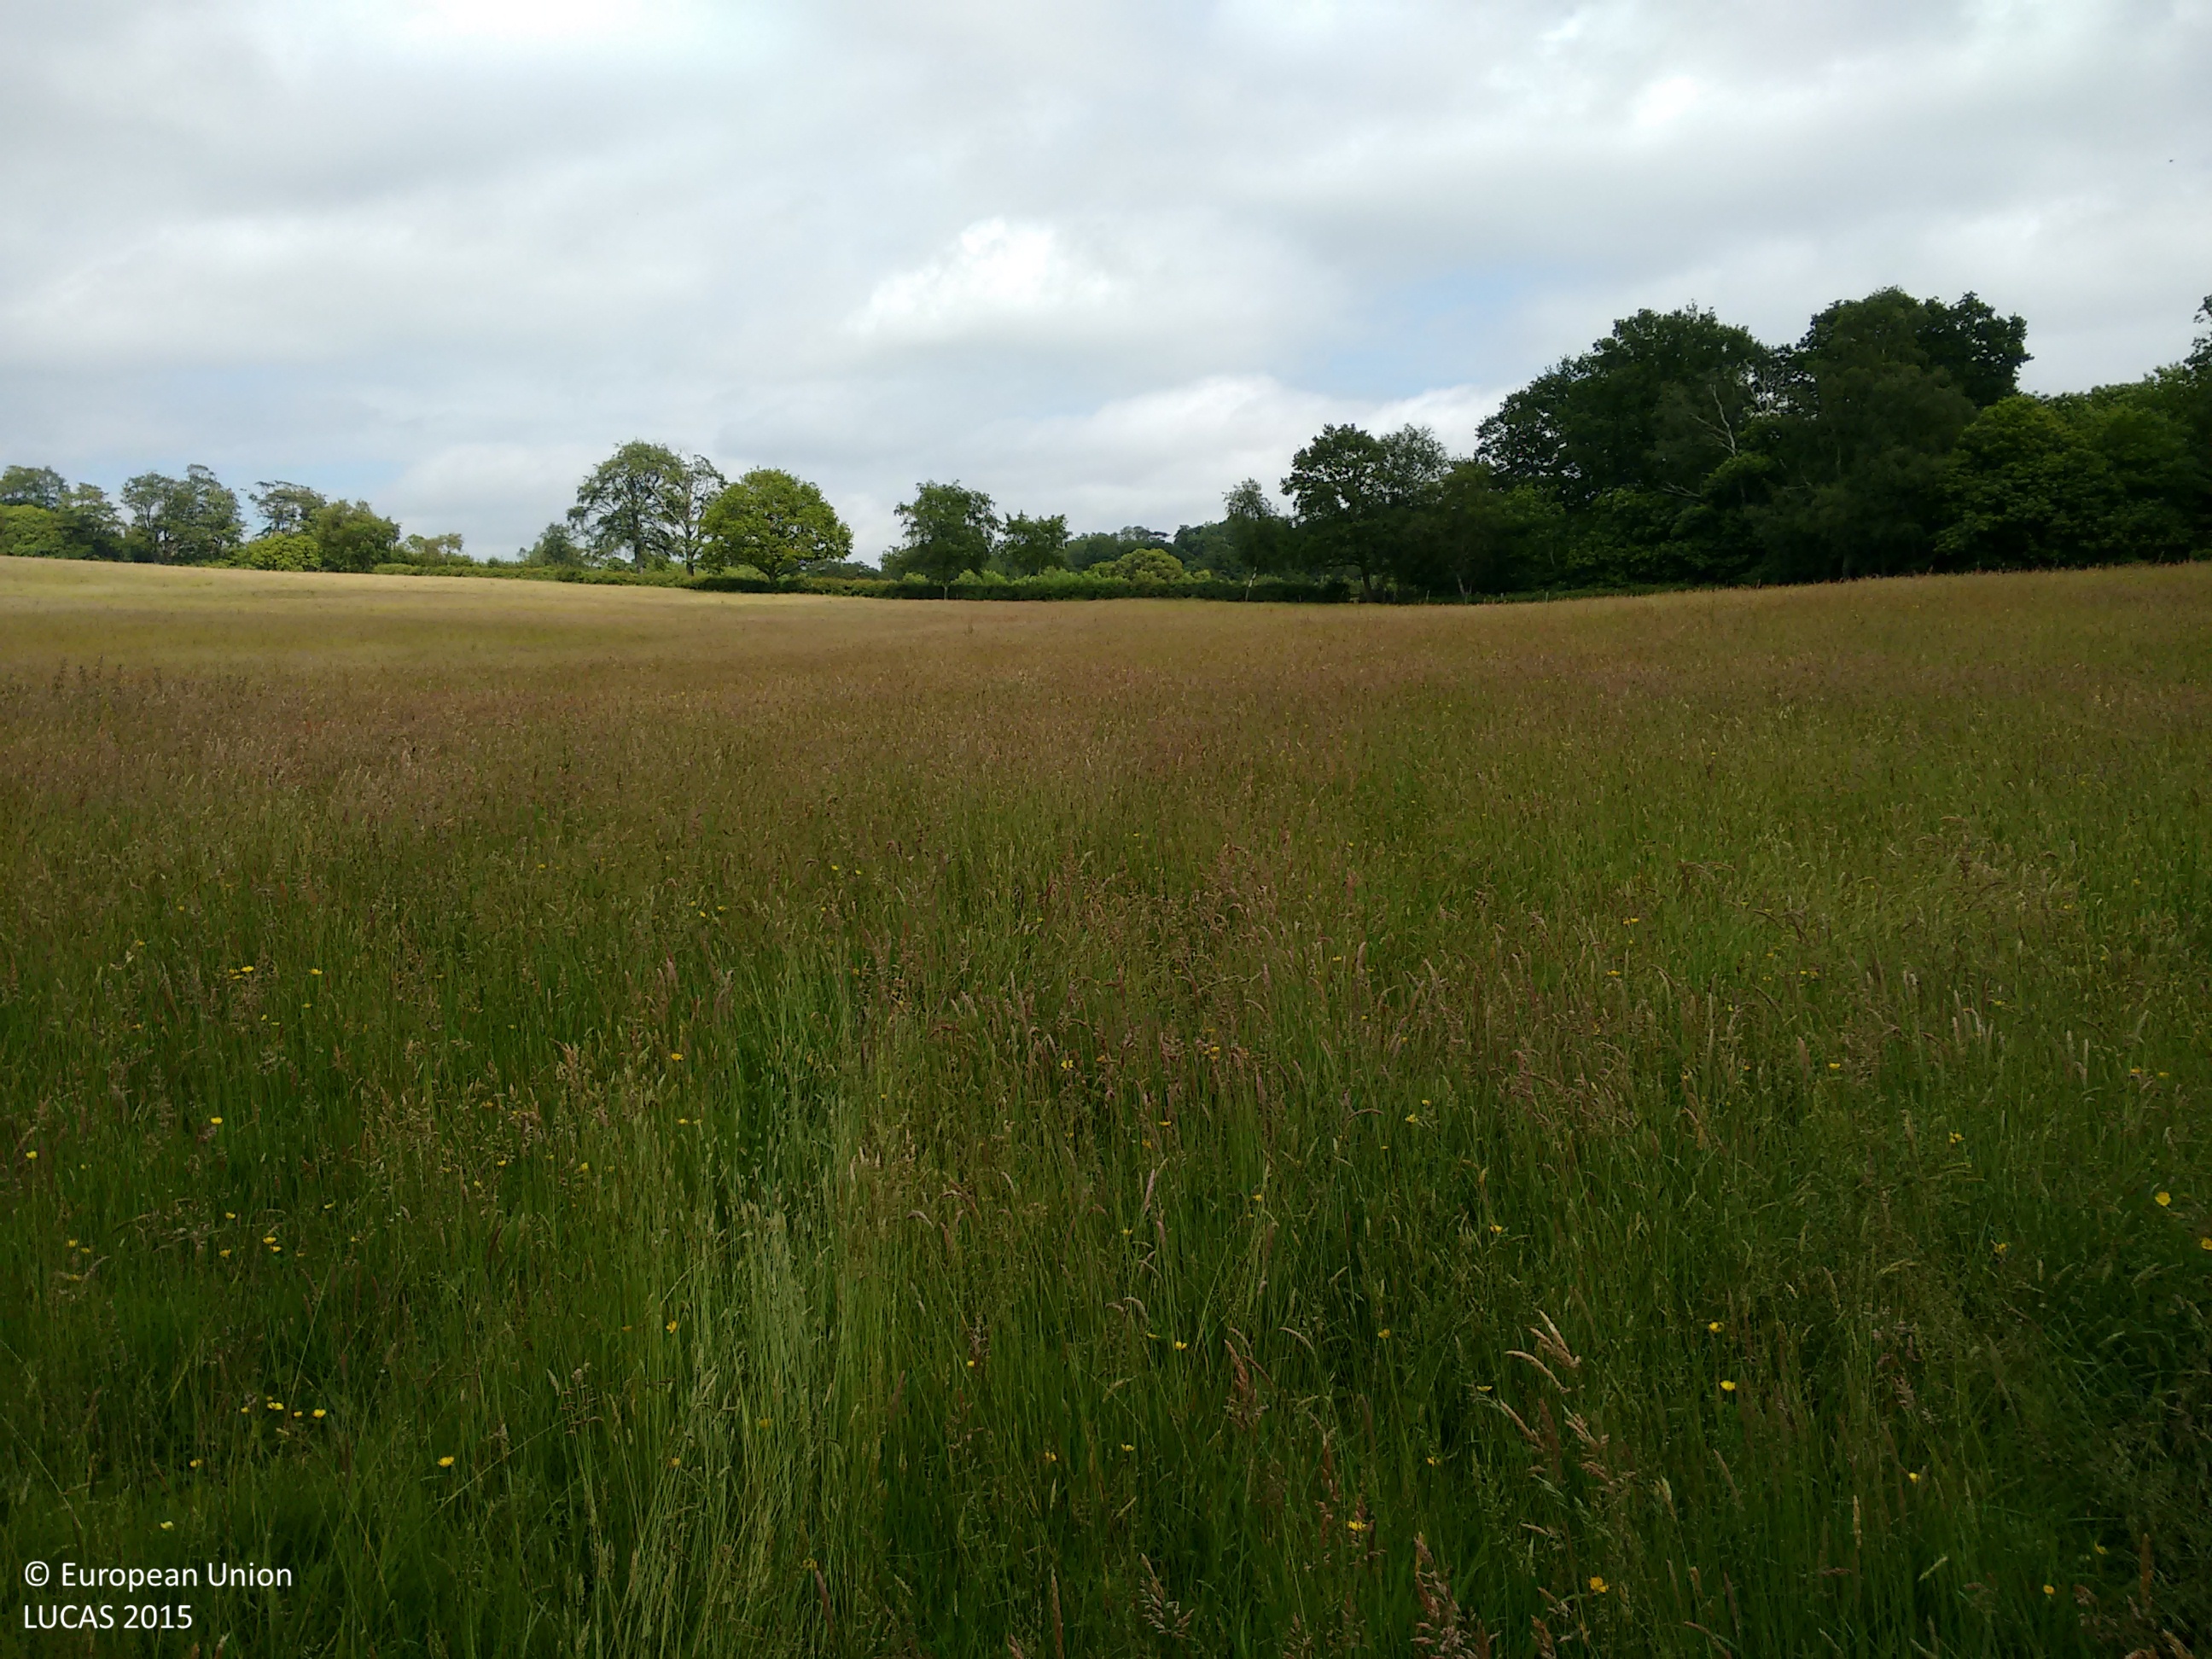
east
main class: Grassland
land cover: Grassland without tree/shrub cover
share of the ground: > 75 %
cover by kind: herbaceous plants 100 %
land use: Agriculture (excluding fallow land and kitchen gardens)
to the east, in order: Grassland without tree/shrub cover; Fences; Broadleaved woodland; Fences; Grassland without tree/shrub cover; Fences; Broadleaved woodland
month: June
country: GB
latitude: 50.9558
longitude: 0.1889
